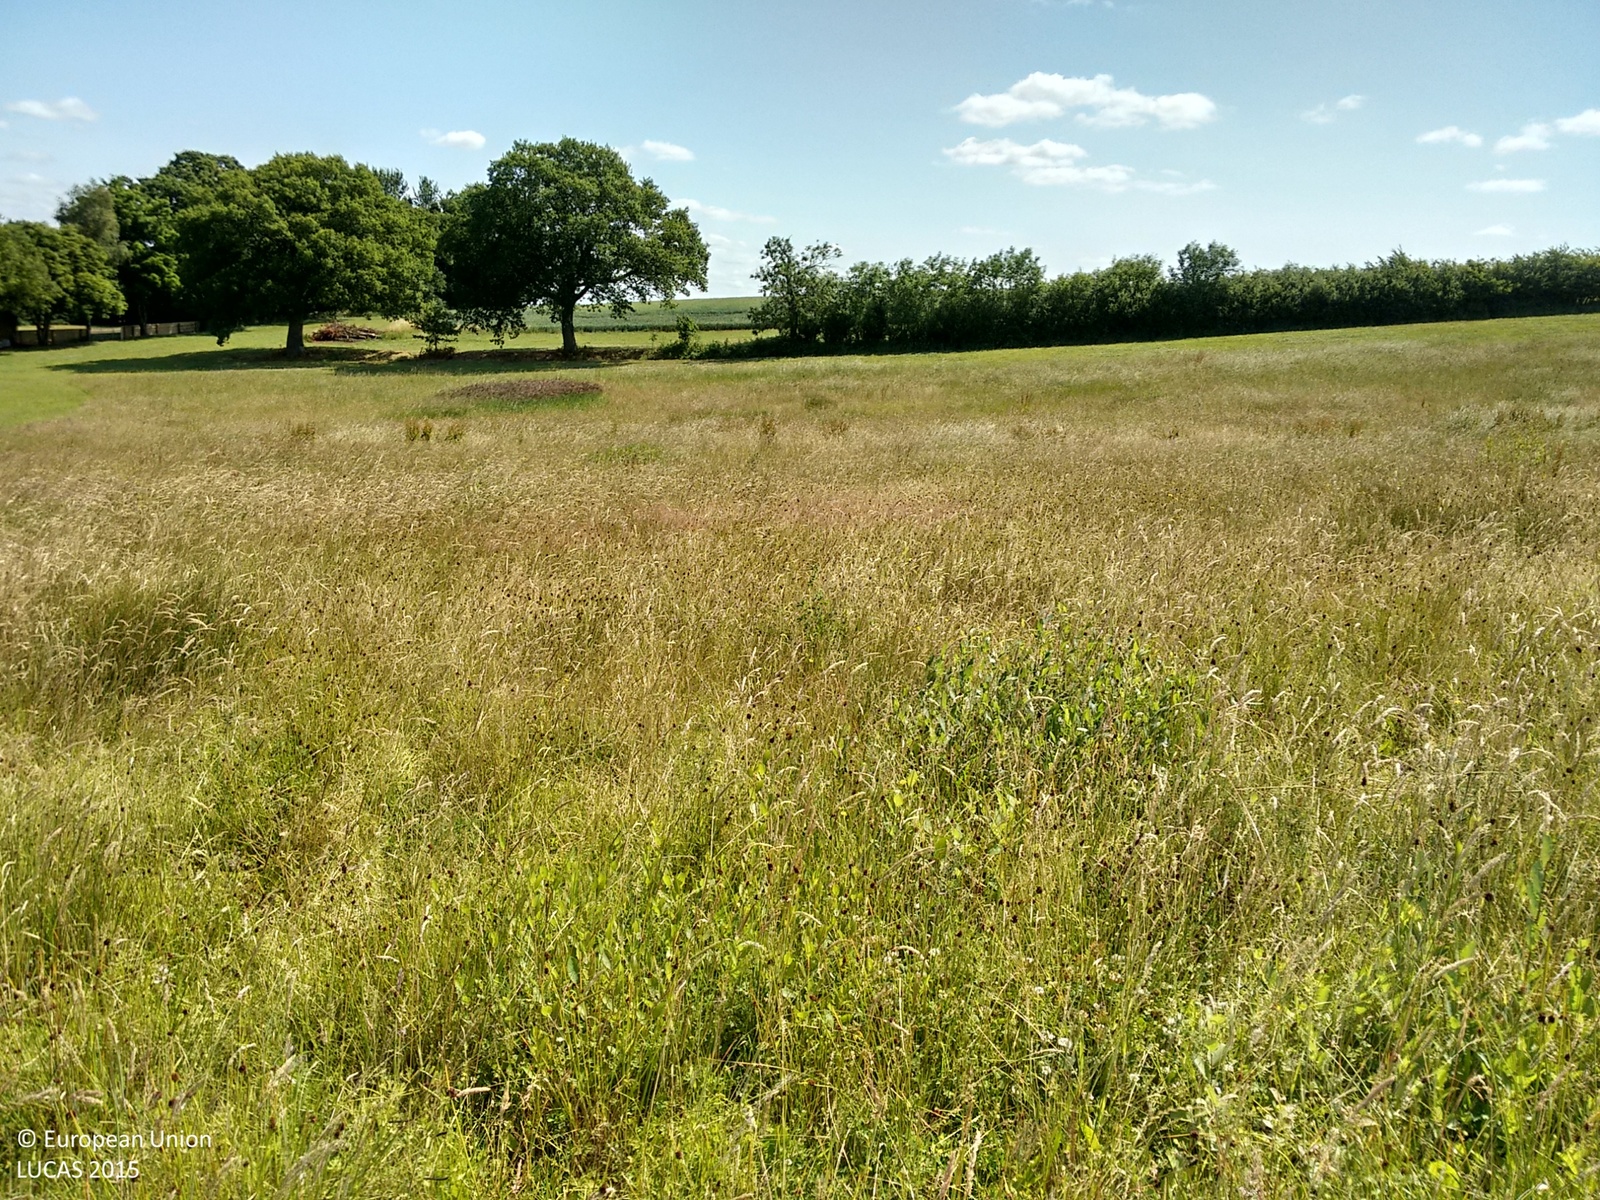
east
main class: Grassland
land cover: Grassland without tree/shrub cover
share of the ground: > 75 %
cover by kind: herbaceous plants 100 %
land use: Agriculture (excluding fallow land and kitchen gardens)
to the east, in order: Grassland without tree/shrub cover; Managed hedges; Grassland without tree/shrub cover; Common wheat
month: July
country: GB
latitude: 51.9576
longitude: -1.3561
